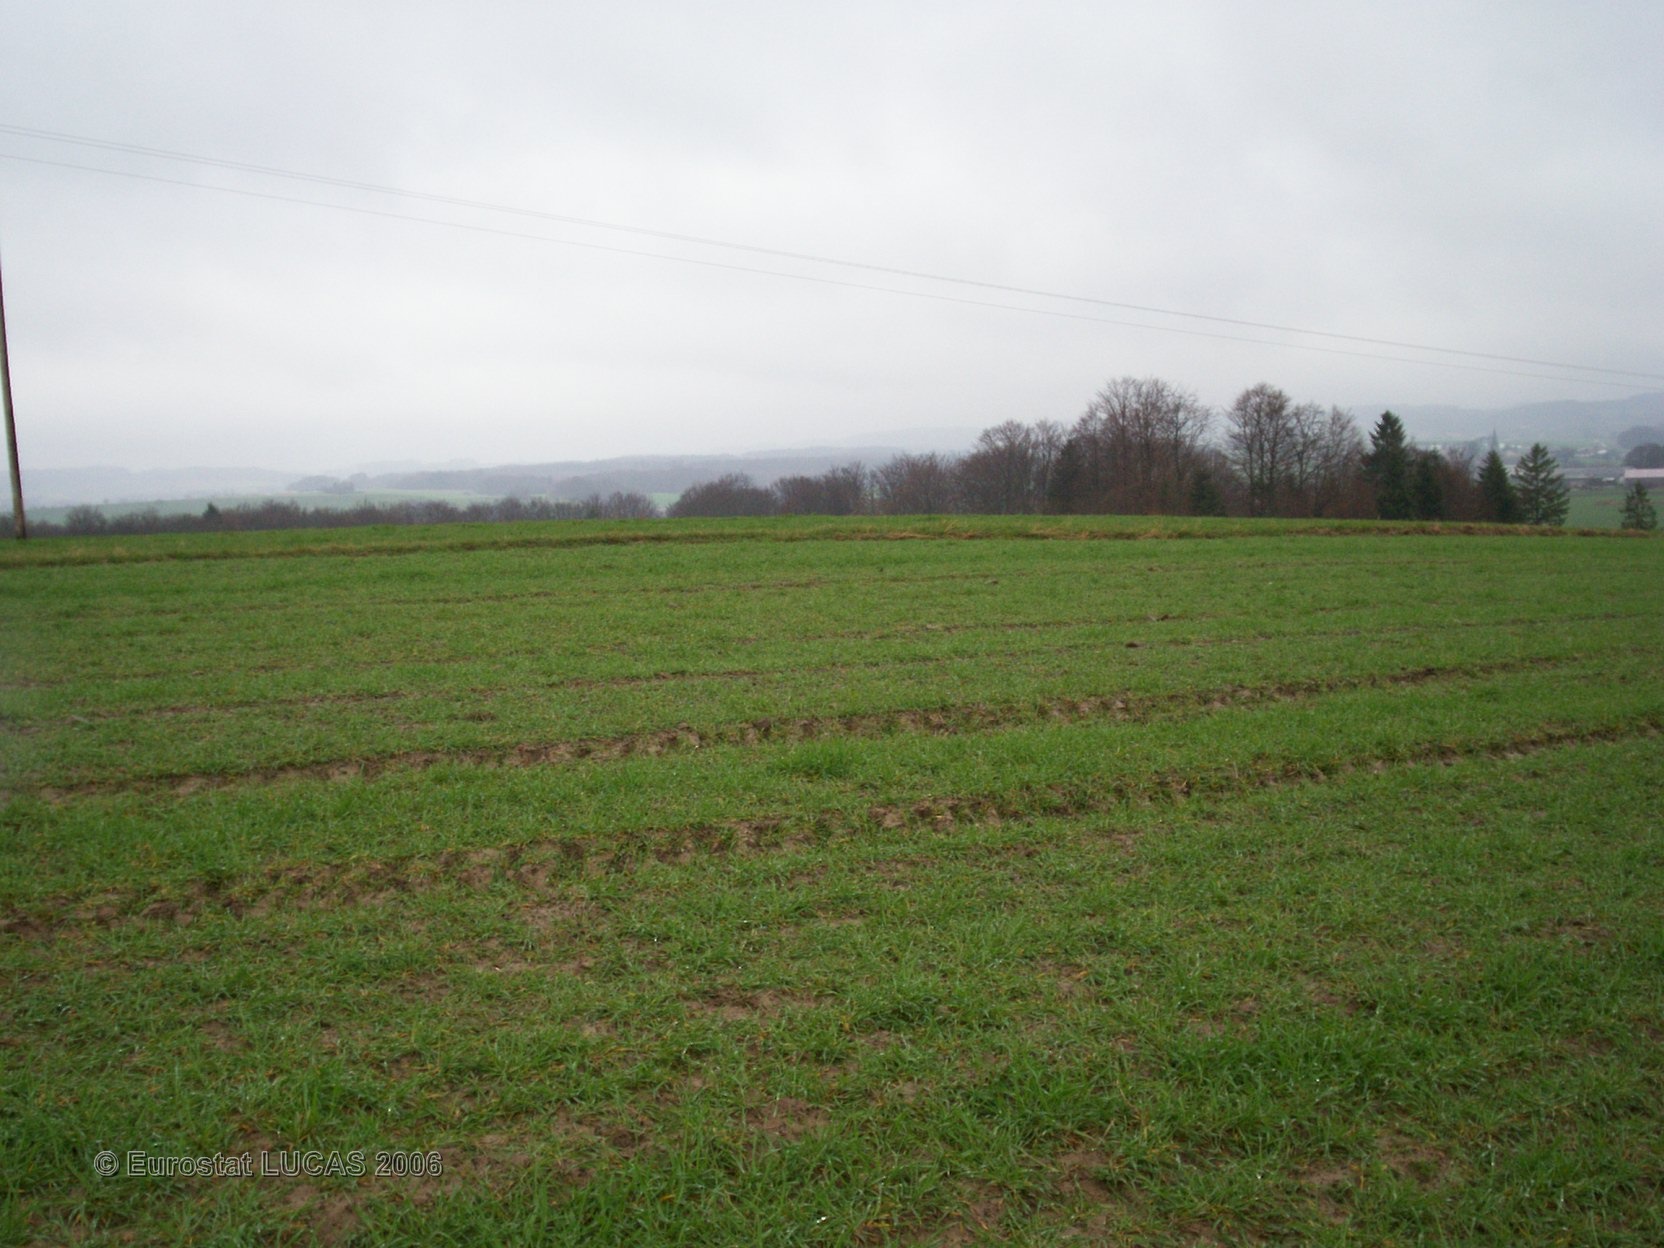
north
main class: Cropland
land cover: Common wheat
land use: Agriculture (excluding fallow land and kitchen gardens)
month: April
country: FR
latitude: 48.0726
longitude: 6.3367
